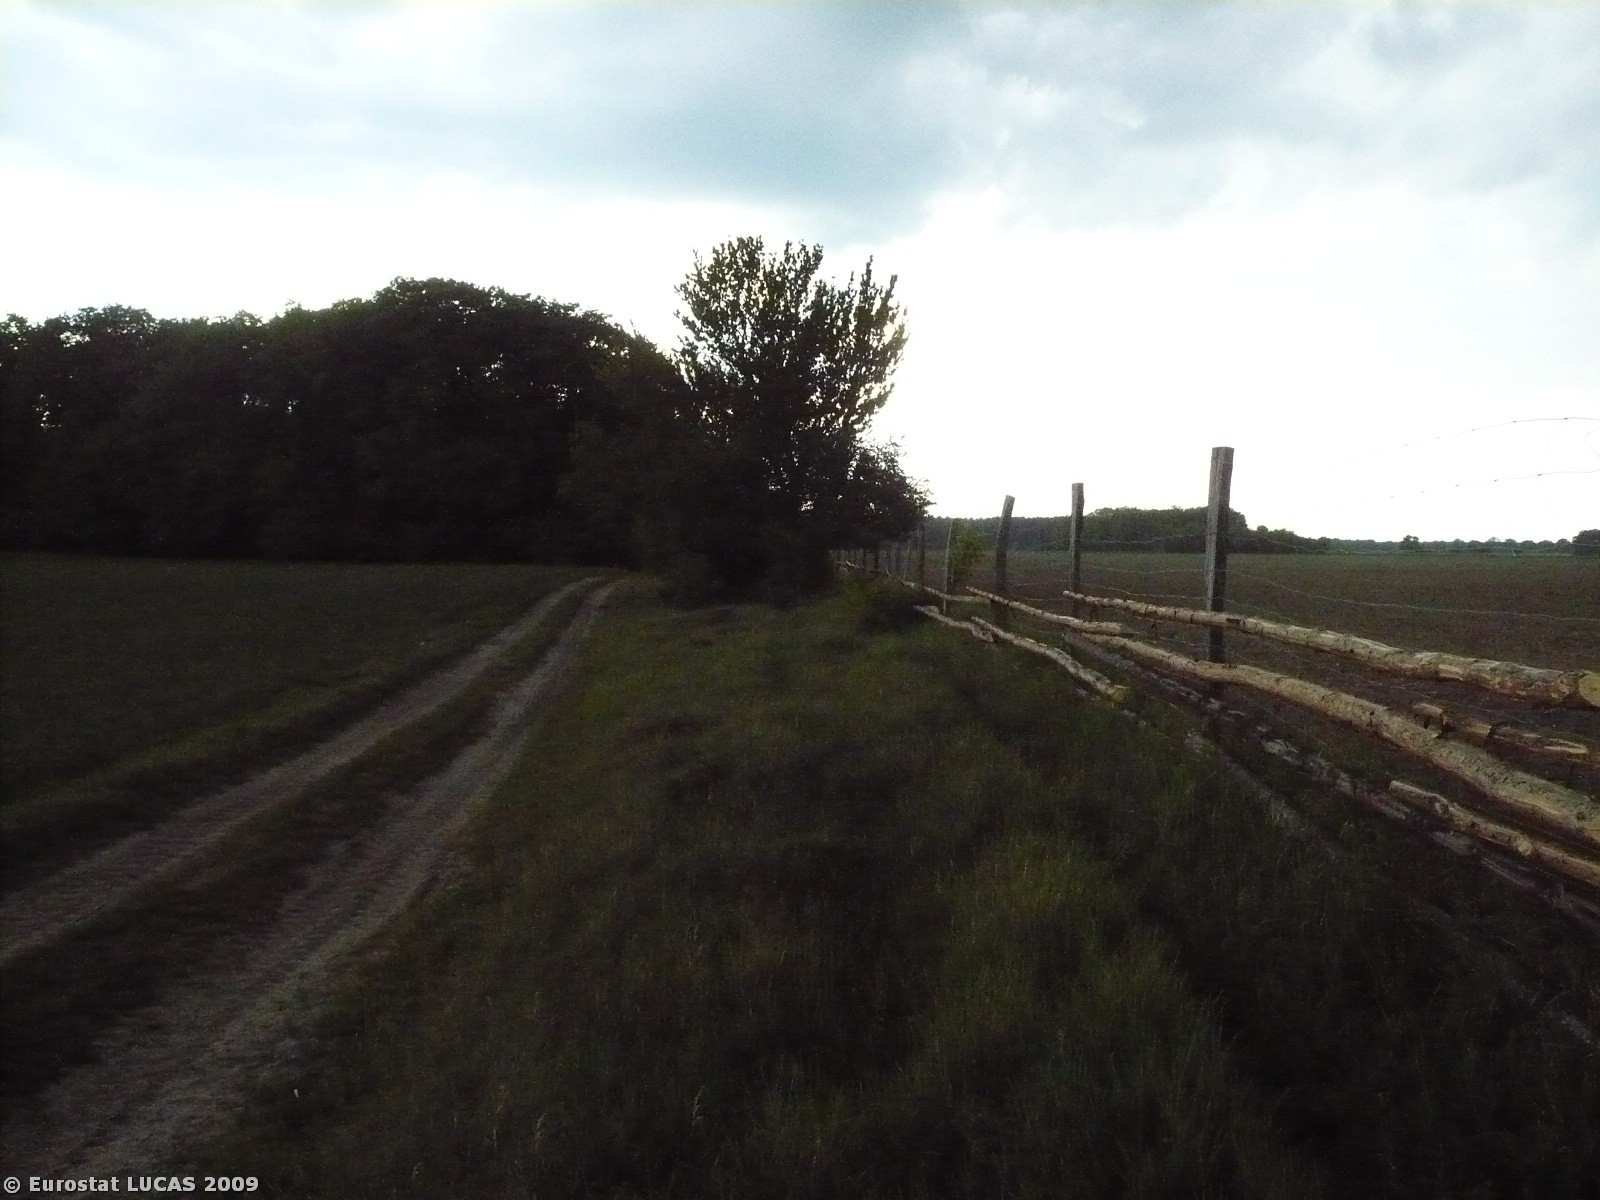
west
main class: Cropland
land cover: Maize
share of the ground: < 10 %
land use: Agriculture (excluding fallow land and kitchen gardens)
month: May
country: PL
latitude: 52.1315
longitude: 15.3358
